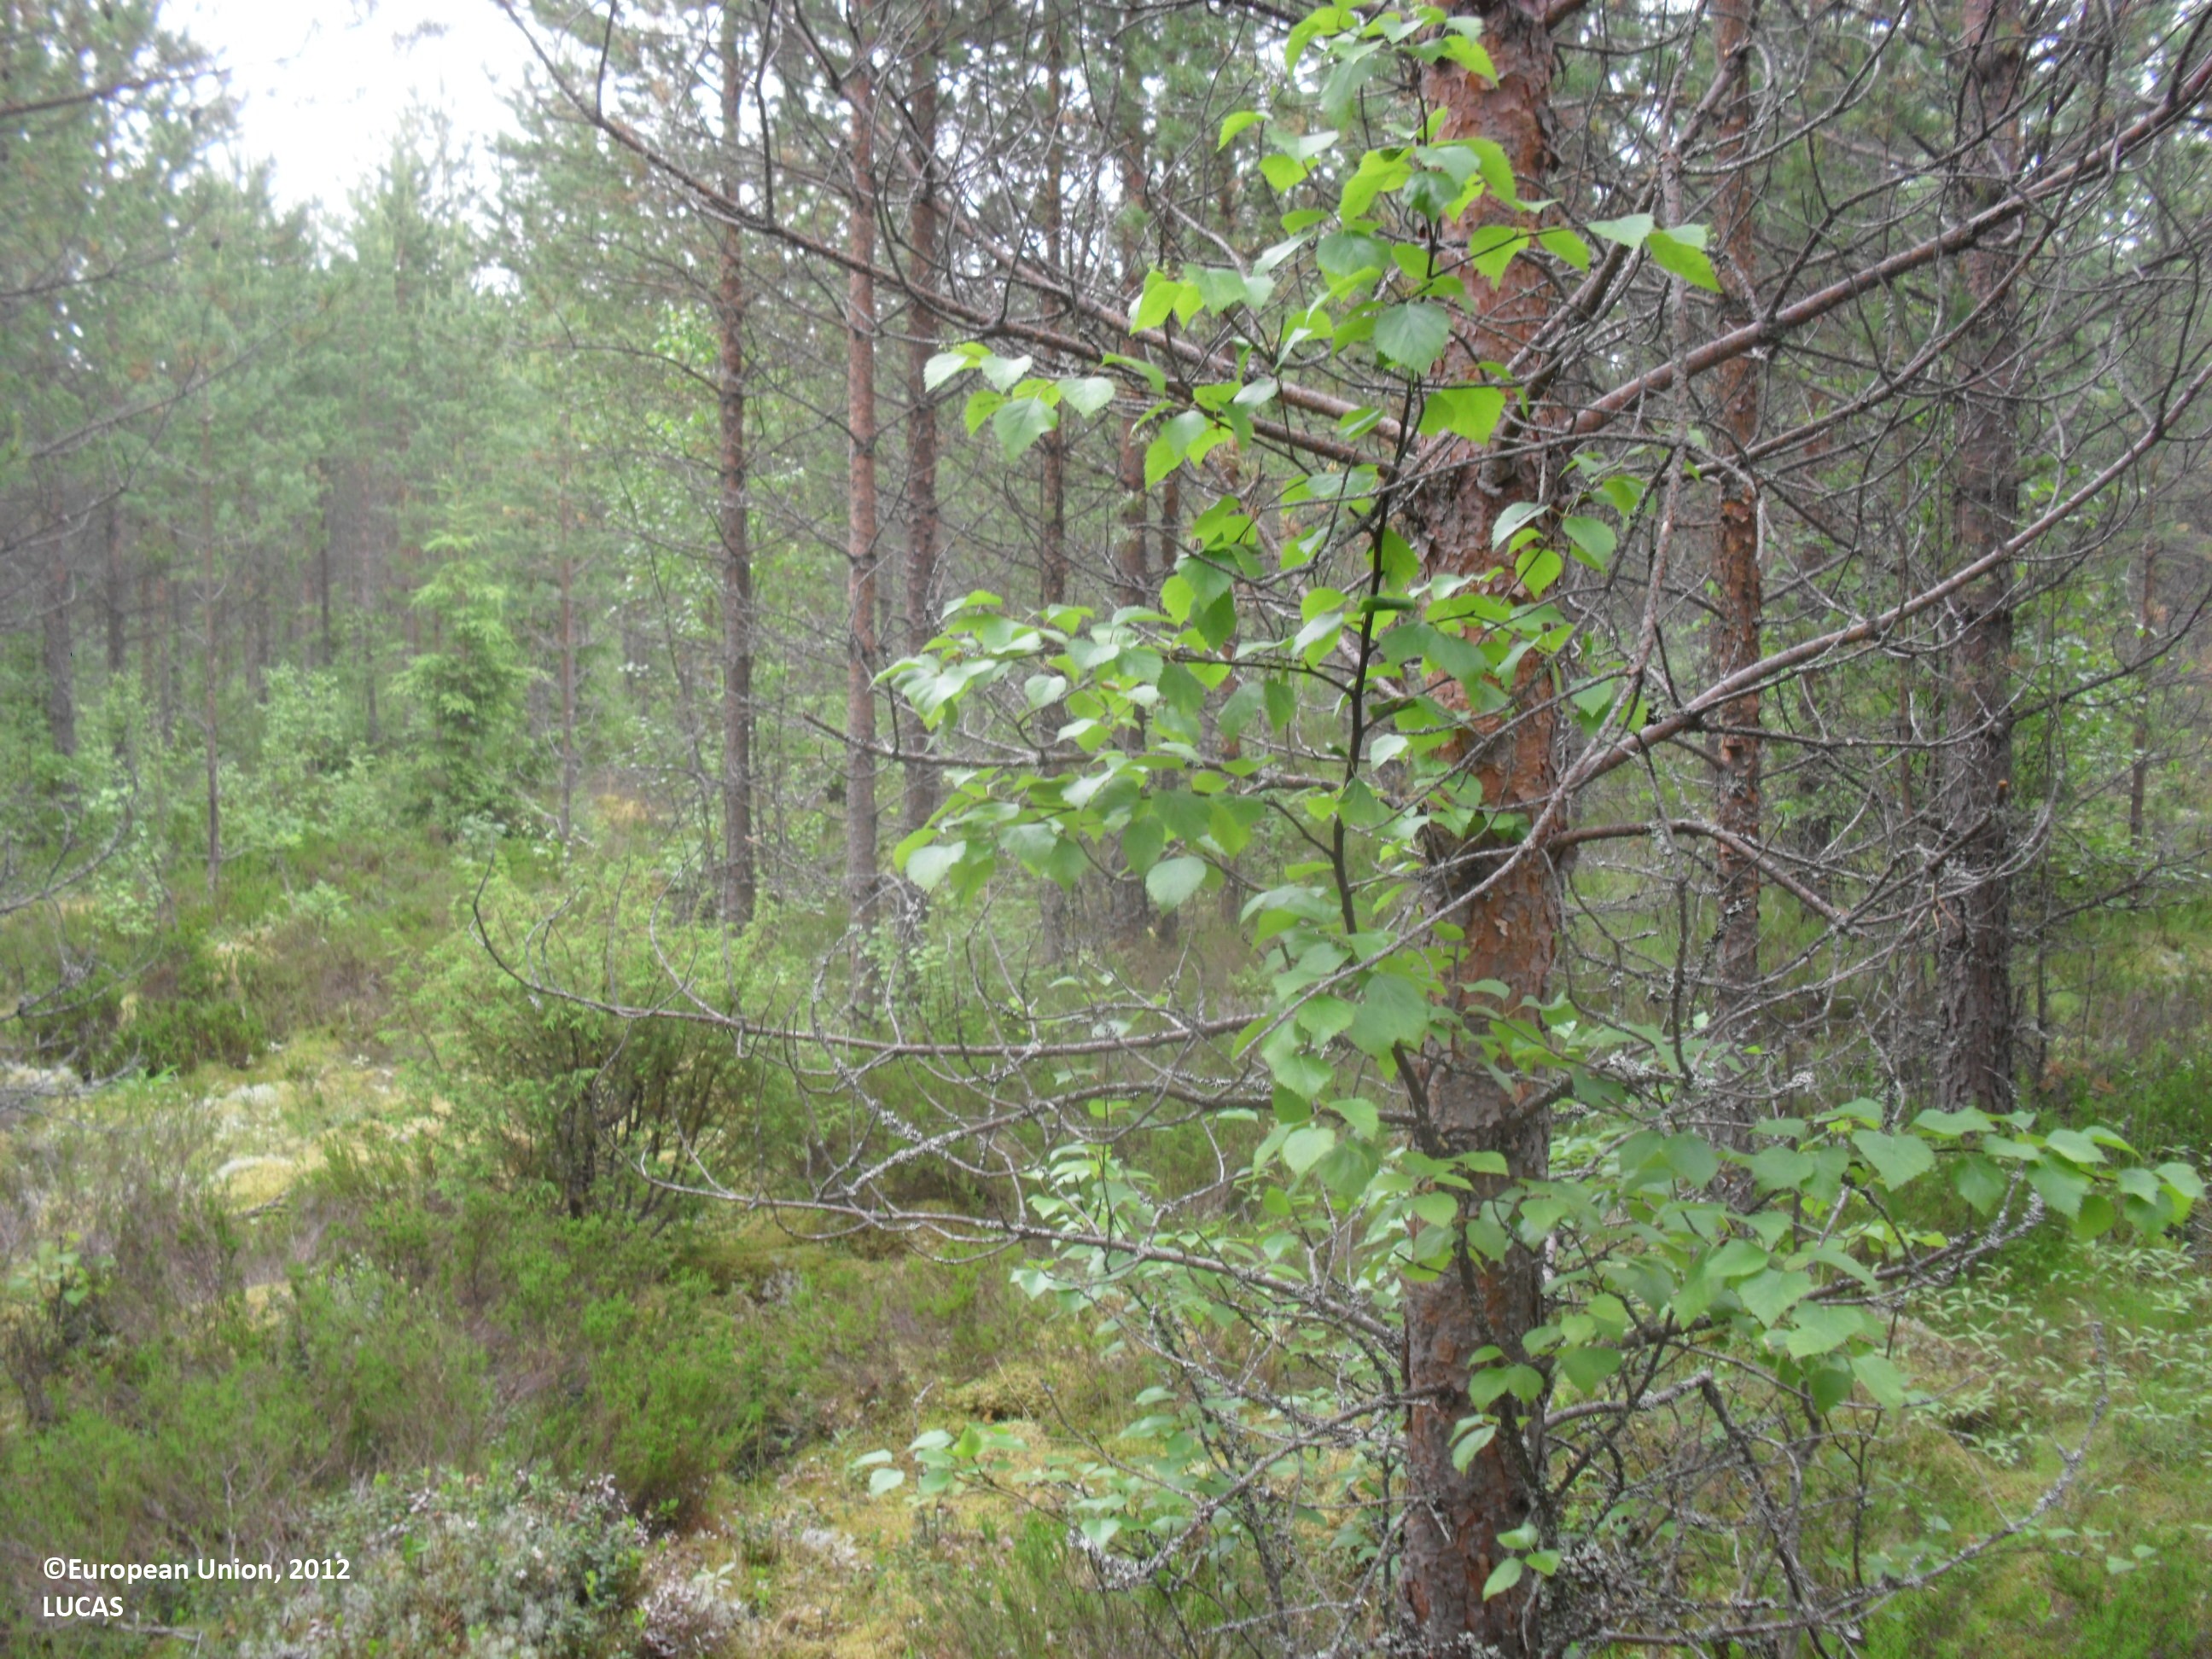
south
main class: Woodland
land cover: Pine dominated coniferous woodland
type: boreal forest
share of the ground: 50 - 75 %
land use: Forestry
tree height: > 5 m
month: June
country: FI
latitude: 62.9099
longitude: 23.5913
